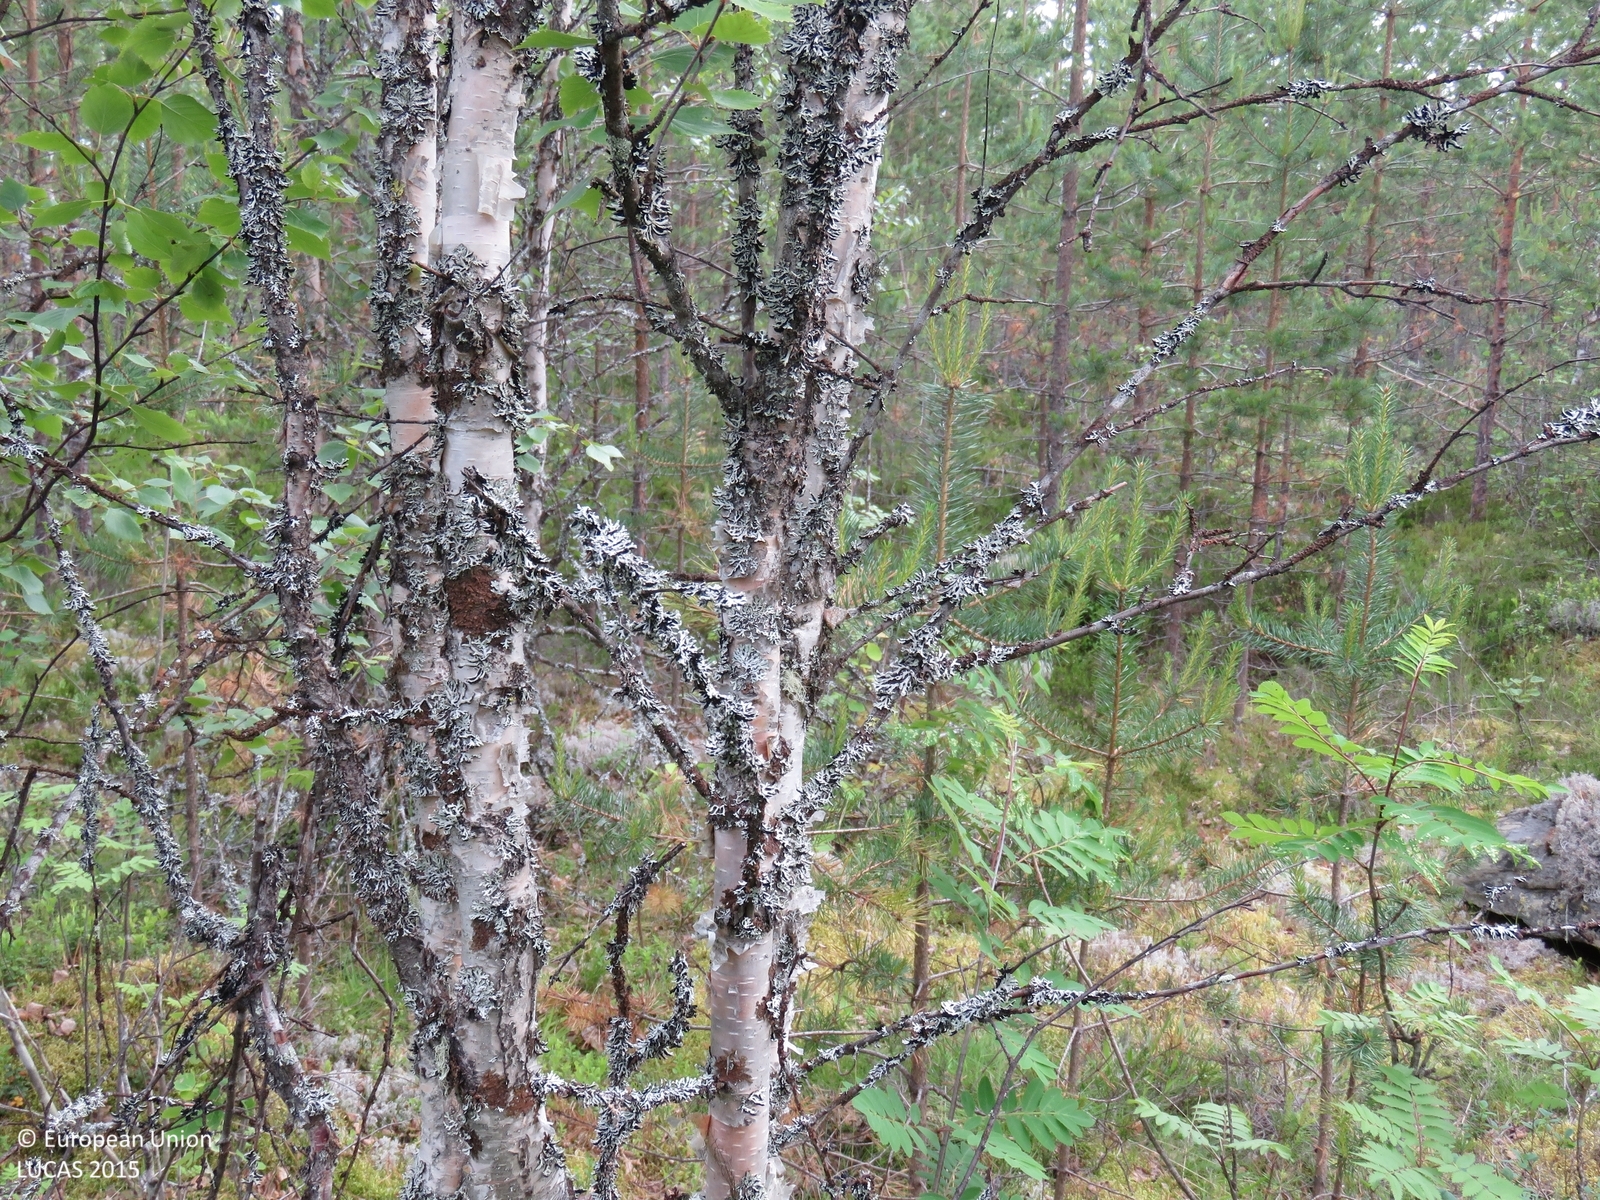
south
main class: Woodland
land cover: Pine dominated mixed woodland
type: boreal forest
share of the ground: > 75 %
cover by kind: coniferous forest trees 45 %, broadleaved forest trees 35 %, shrubs 10 %, herbaceous plants 5 %, lichens and mosses 5 %
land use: Forestry
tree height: > 5 m
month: July
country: FI
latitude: 64.4813
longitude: 26.4019
